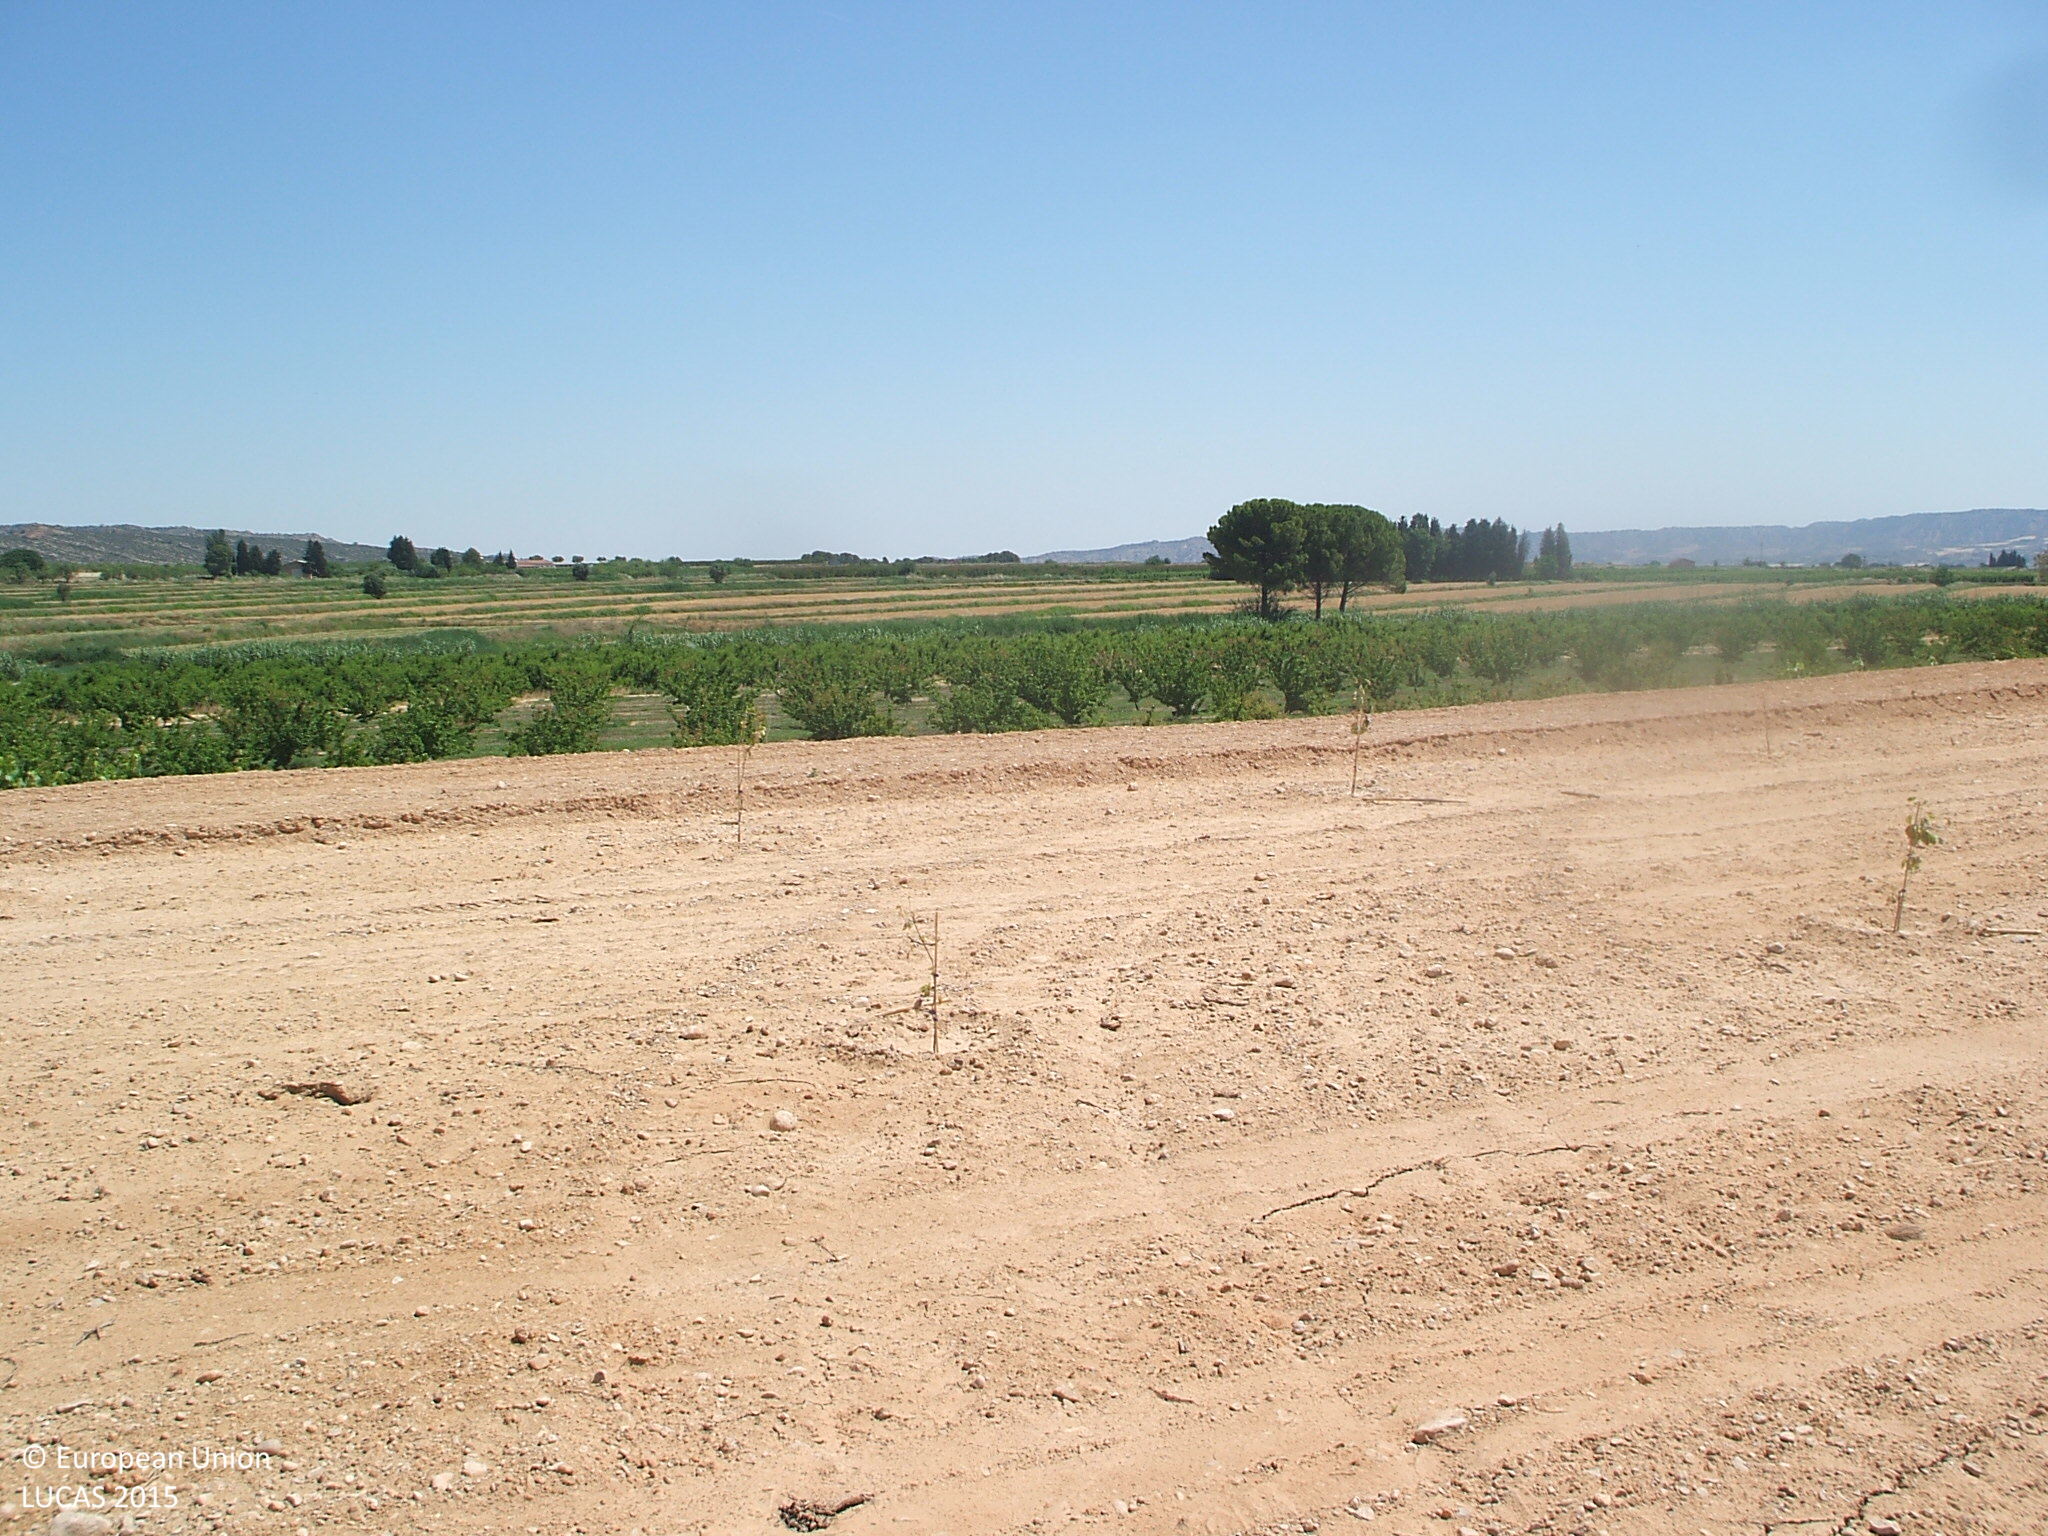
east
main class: Cropland
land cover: Nuts trees
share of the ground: < 10 %
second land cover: Other bare soil
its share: > 75 %
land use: Agriculture (excluding fallow land and kitchen gardens)
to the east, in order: Nuts trees; Other bare soil; Spontaneously vegetated surfaces; Other fruit trees and berries; Shruby margins; Other bare soil; Grass margins; Paved roads, cycling and walking lanes; Grass margins; Other fruit trees and berries; Grass margins; Tracks; Grassland without tree/shrub cover; Ditches and canals; Grass margins; Barley
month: June
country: ES
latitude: 41.1119
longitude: -0.2661
